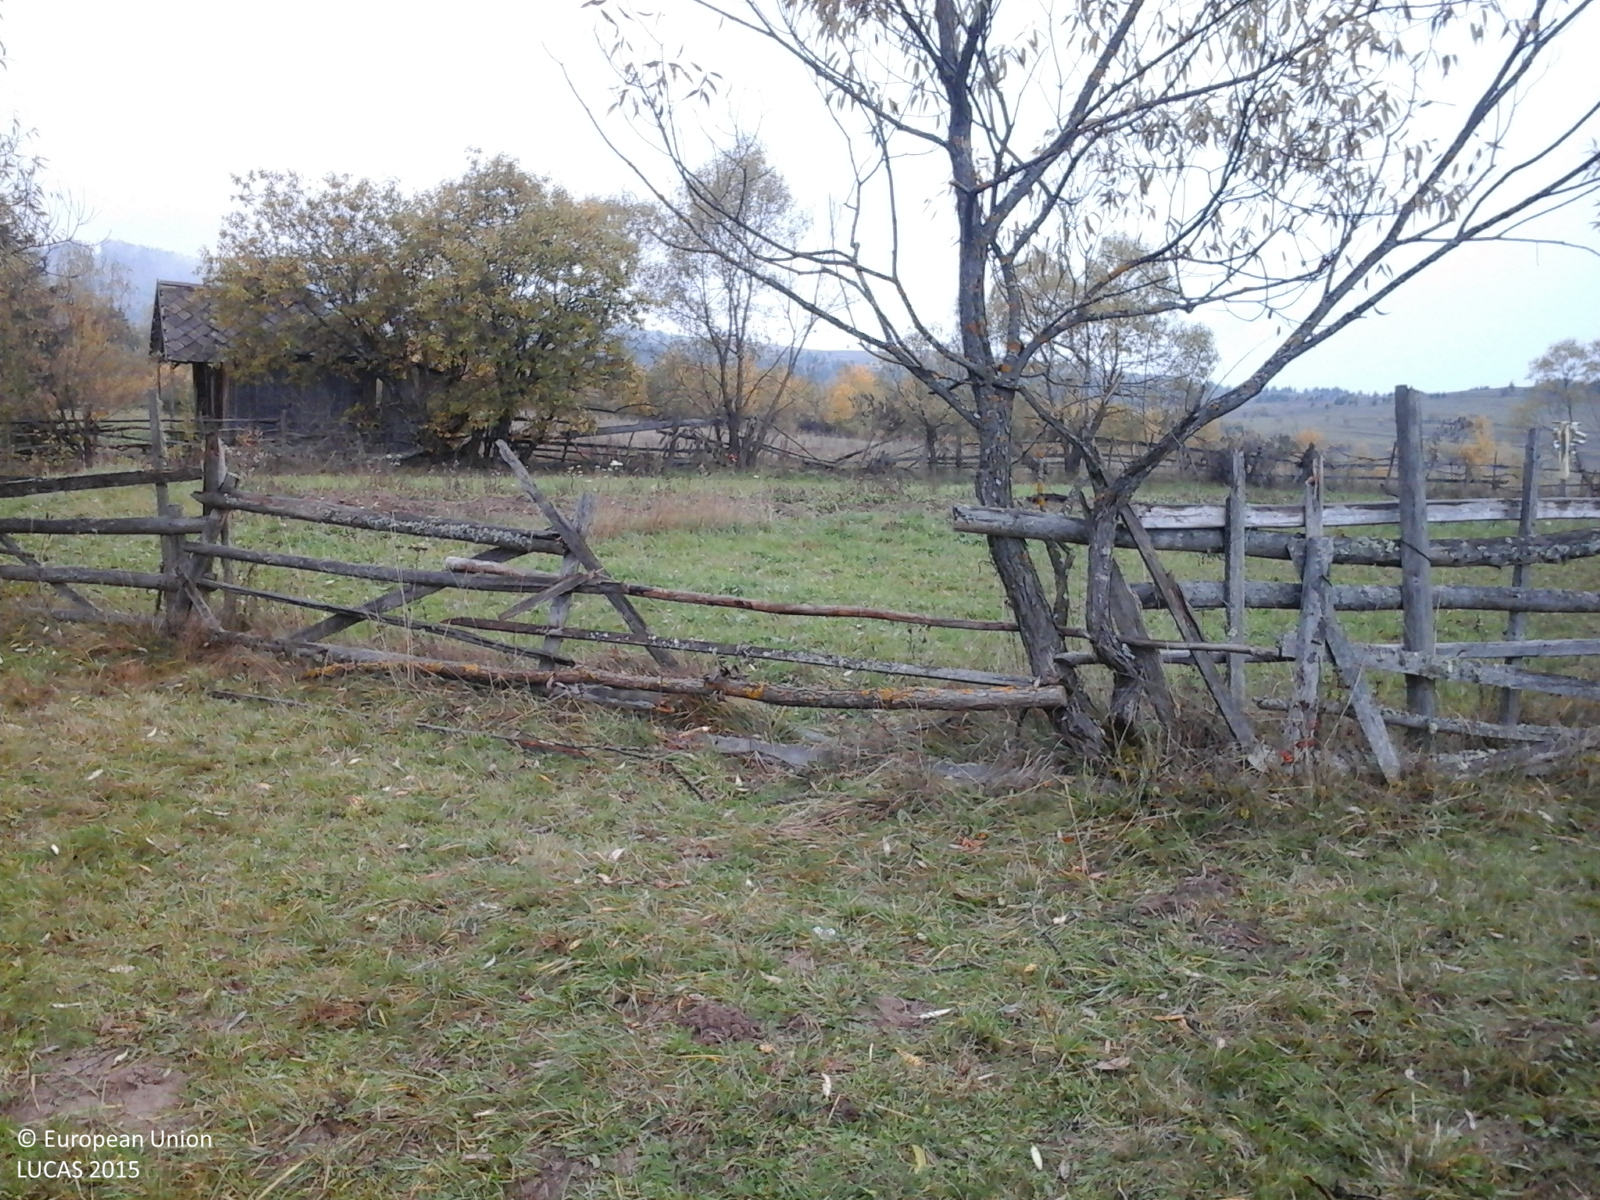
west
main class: Grassland
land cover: Grassland without tree/shrub cover
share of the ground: > 75 %
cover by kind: herbaceous plants 100 %
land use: Agriculture (excluding fallow land and kitchen gardens)
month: October
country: RO
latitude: 46.9059
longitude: 25.3232
